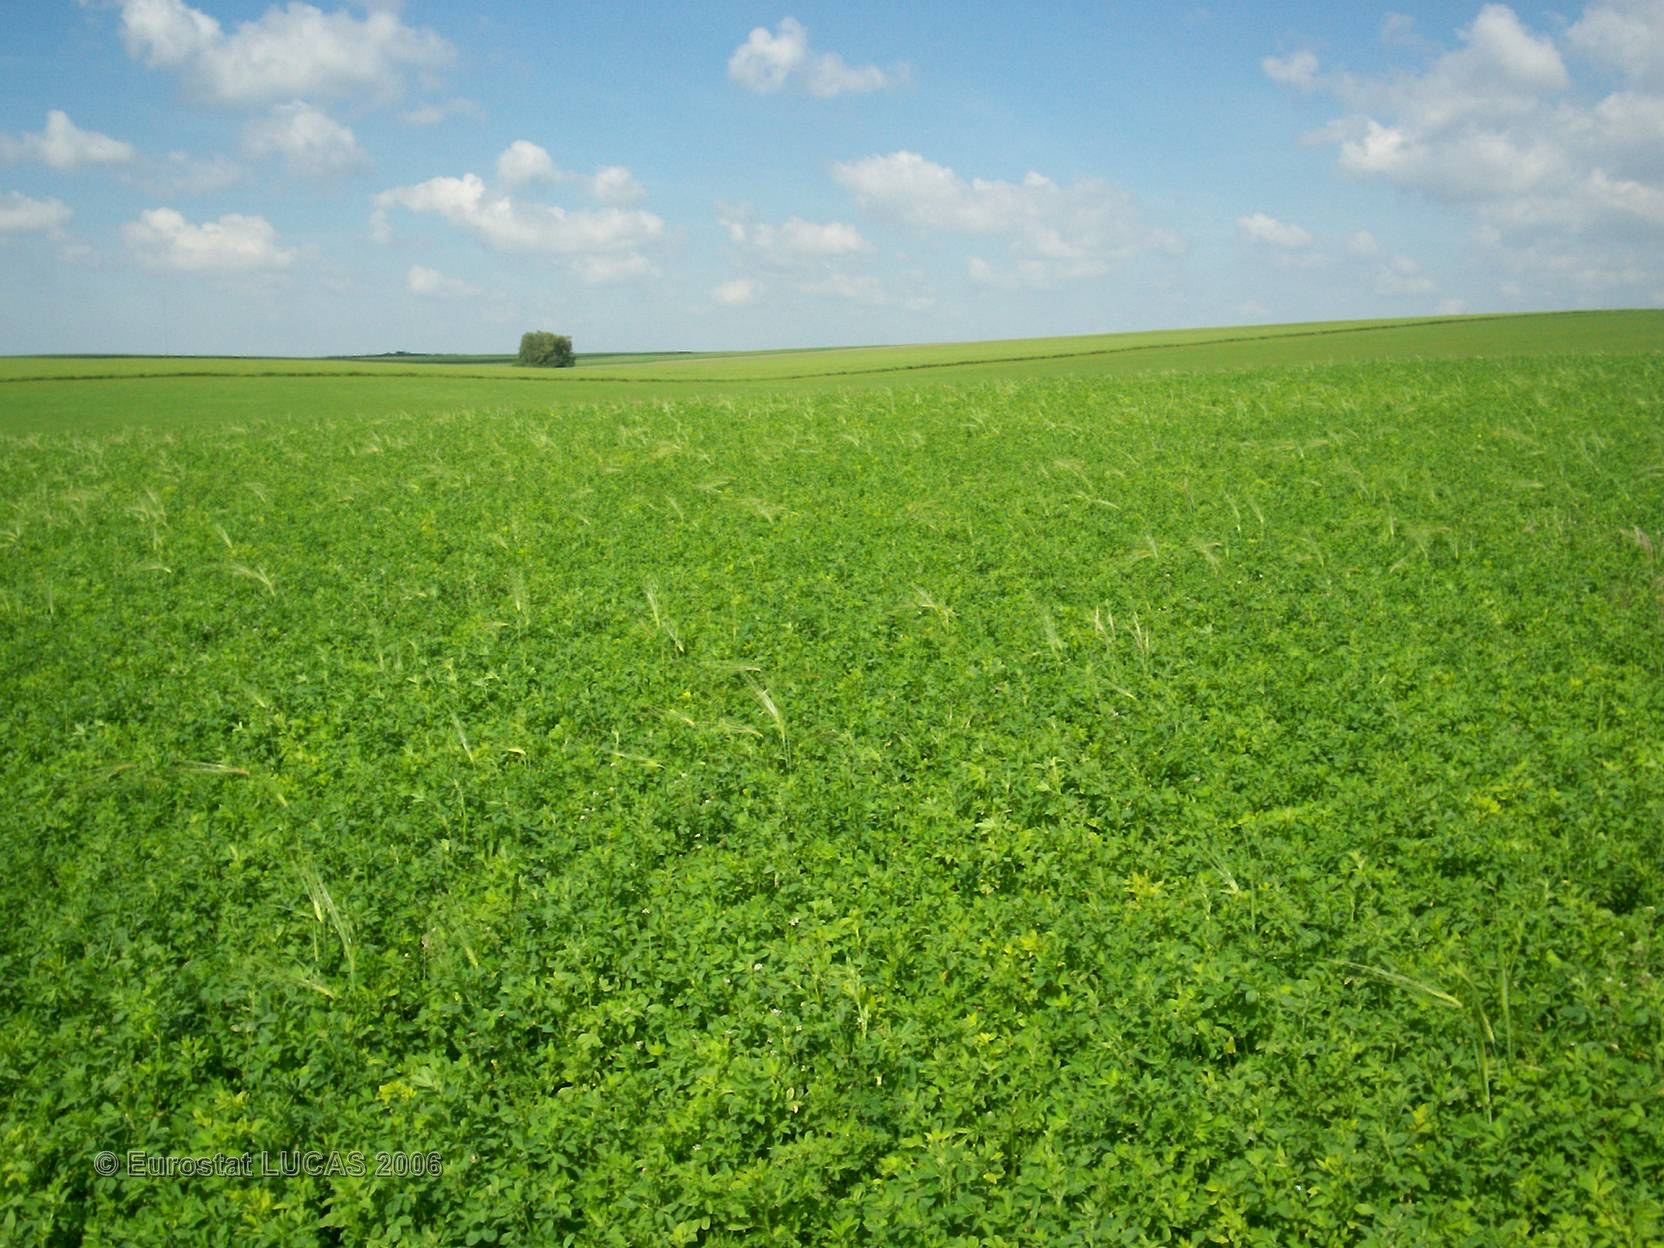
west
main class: Cropland
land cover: Lucerne
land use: Agriculture (excluding fallow land and kitchen gardens)
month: June
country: FR
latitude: 48.8040
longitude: 4.4280
